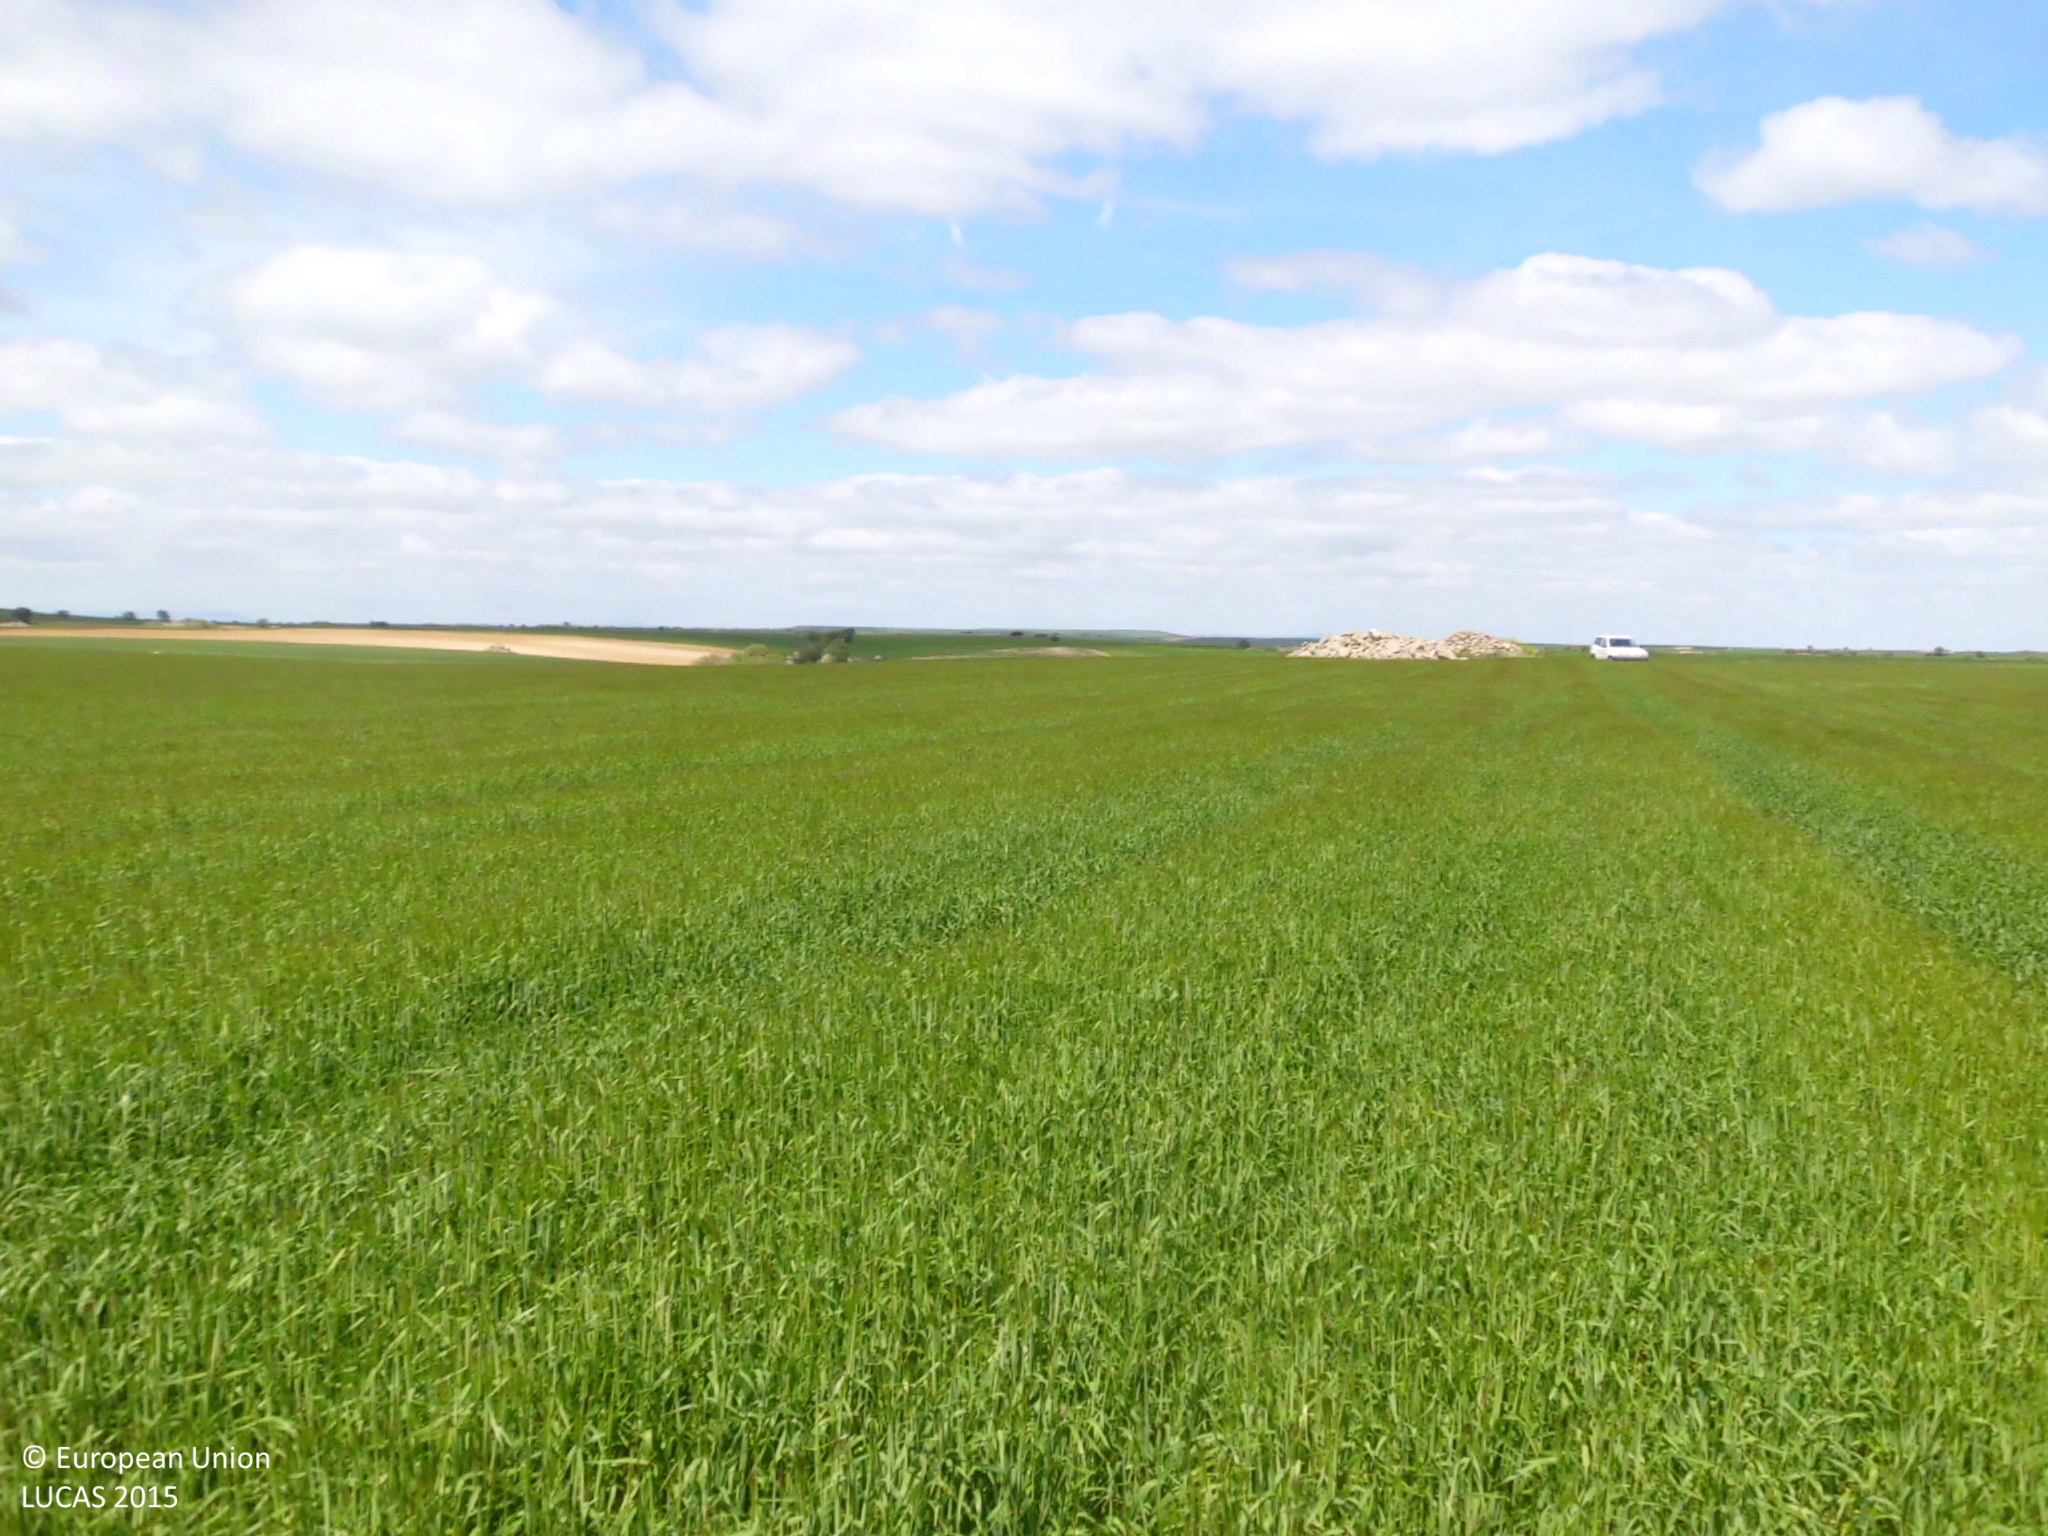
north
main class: Cropland
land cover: Barley
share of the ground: > 75 %
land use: Agriculture (excluding fallow land and kitchen gardens)
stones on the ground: 10 - 25 %
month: May
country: ES
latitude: 42.2983
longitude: -4.0017
